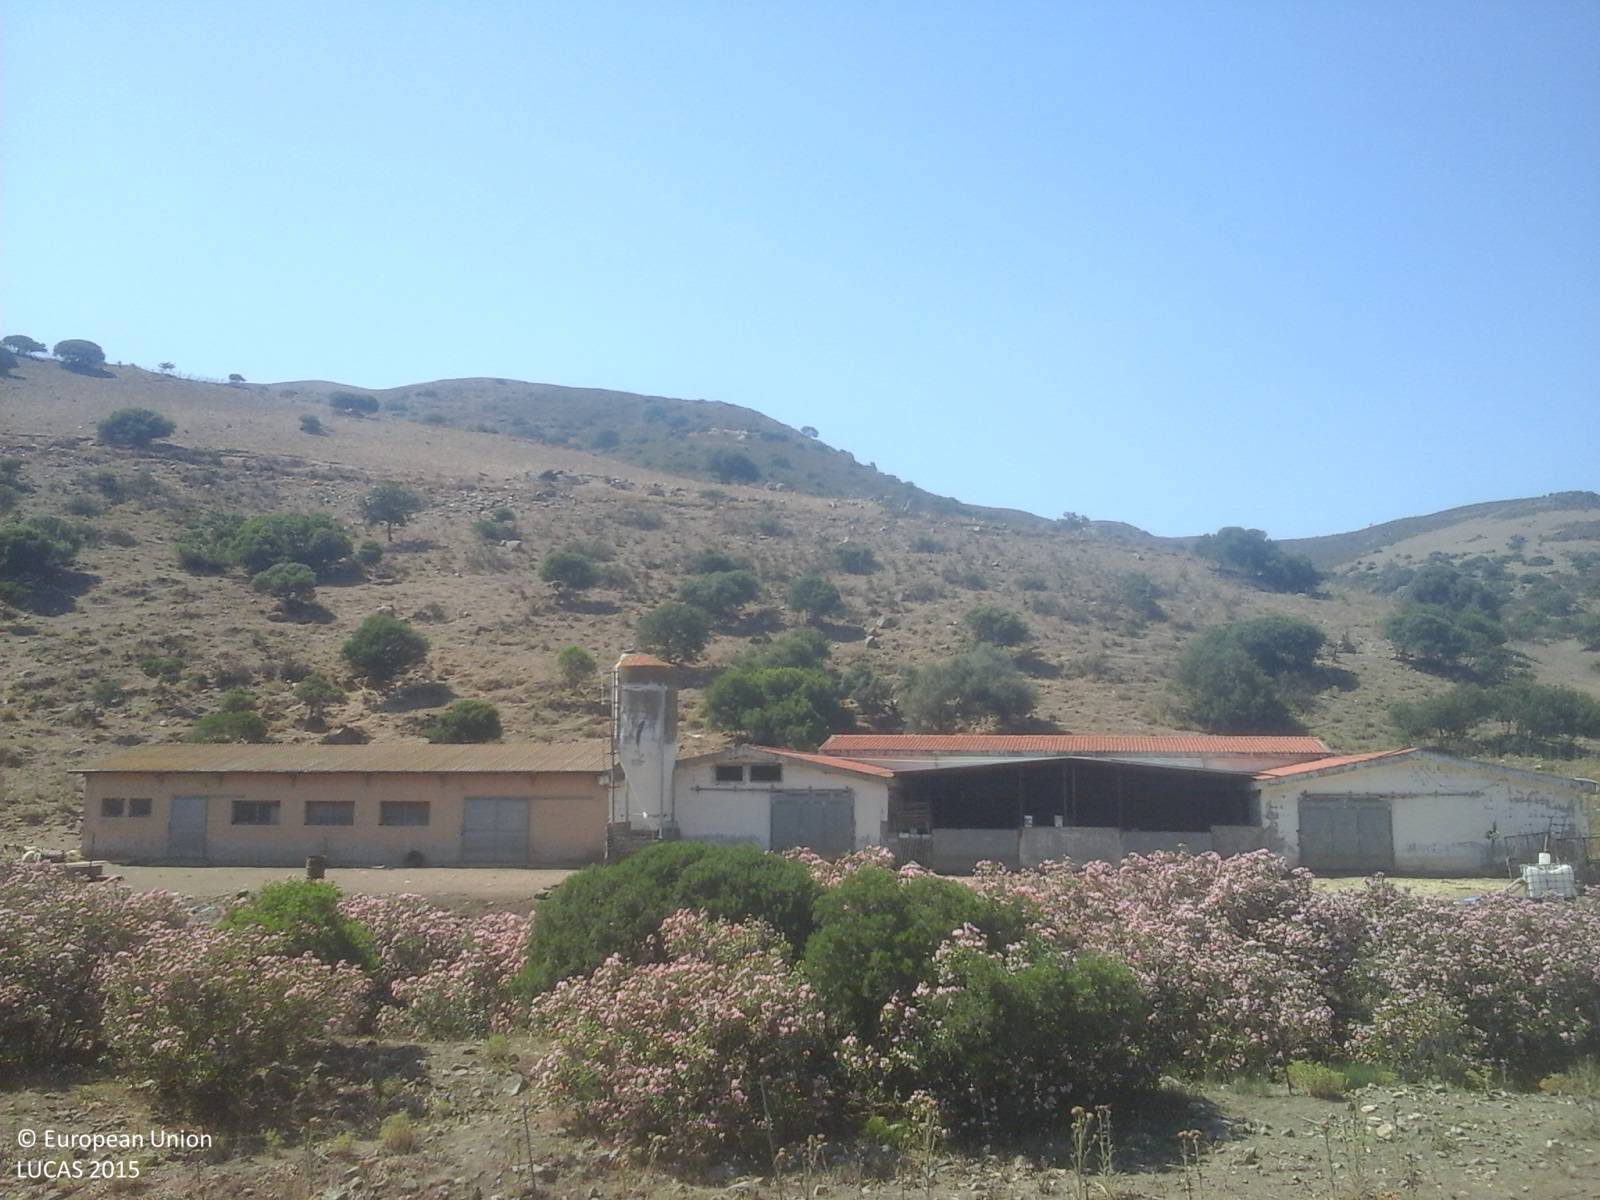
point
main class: Shrubland
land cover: Shrubland with sparse tree cover
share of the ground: > 75 %
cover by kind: shrubs 45 %, unconsolidated bare surface 30 %, herbaceous plants 20 %, broadleaved forest trees 5 %
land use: Agriculture (excluding fallow land and kitchen gardens)
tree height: < 5 m
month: July
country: IT
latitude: 39.4495
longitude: 9.2492
